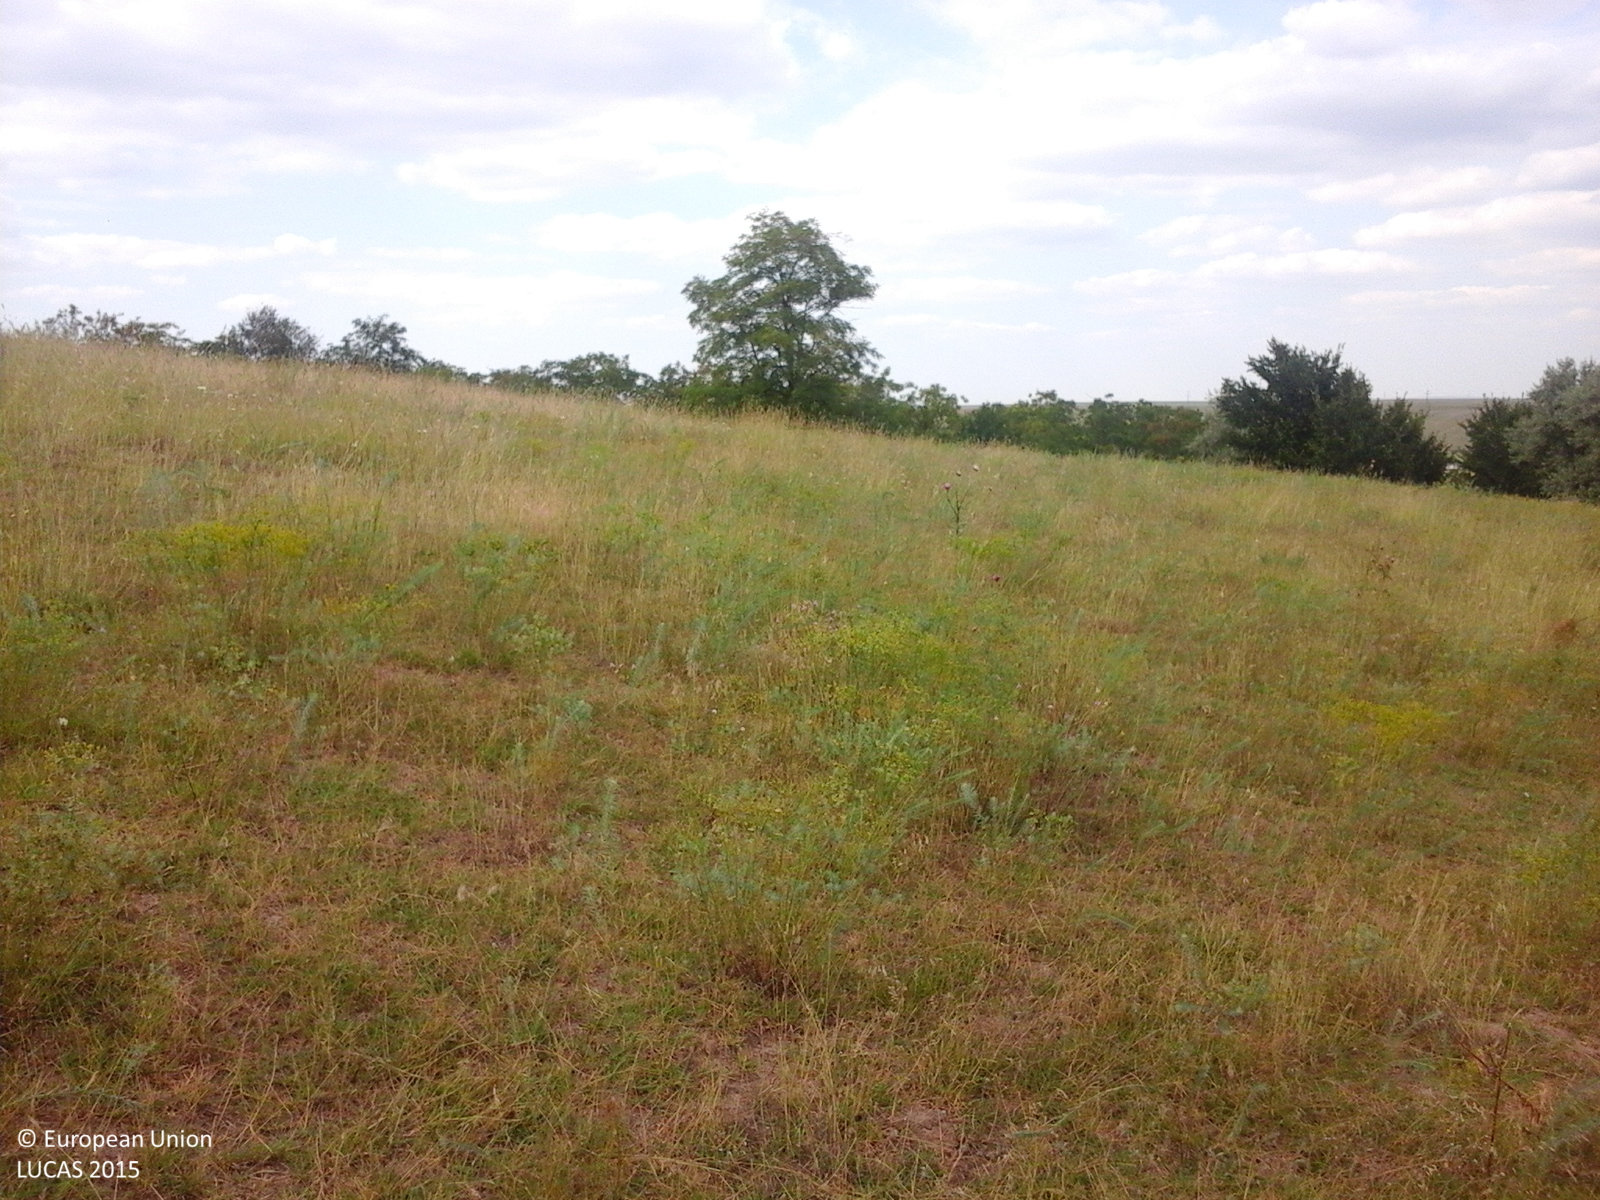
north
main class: Grassland
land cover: Grassland without tree/shrub cover
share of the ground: > 75 %
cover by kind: herbaceous plants 100 %
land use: Agriculture (excluding fallow land and kitchen gardens)
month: August
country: RO
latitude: 44.7118
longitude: 28.1264
